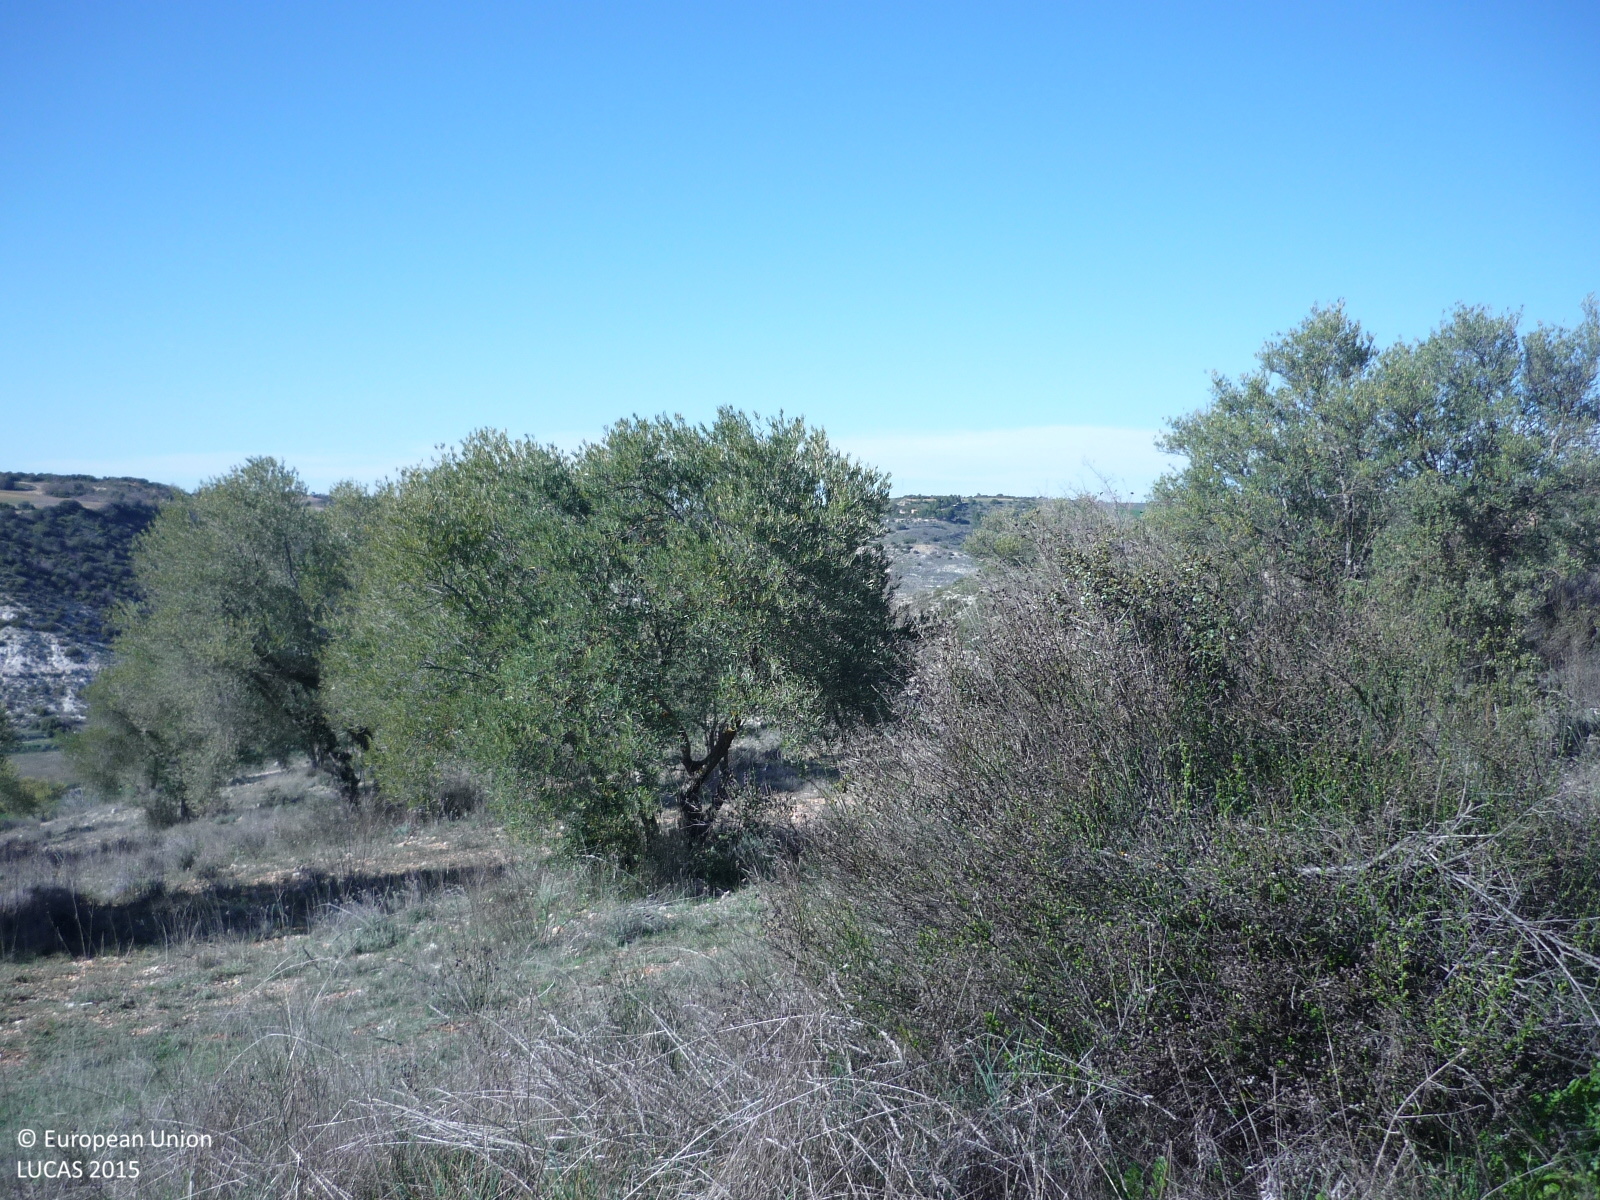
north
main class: Cropland
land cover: Olive groves
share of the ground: 25 - 50 %
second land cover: Other bare soil
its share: > 75 %
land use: Agriculture (excluding fallow land and kitchen gardens)
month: March
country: ES
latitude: 40.3555
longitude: -3.2300
